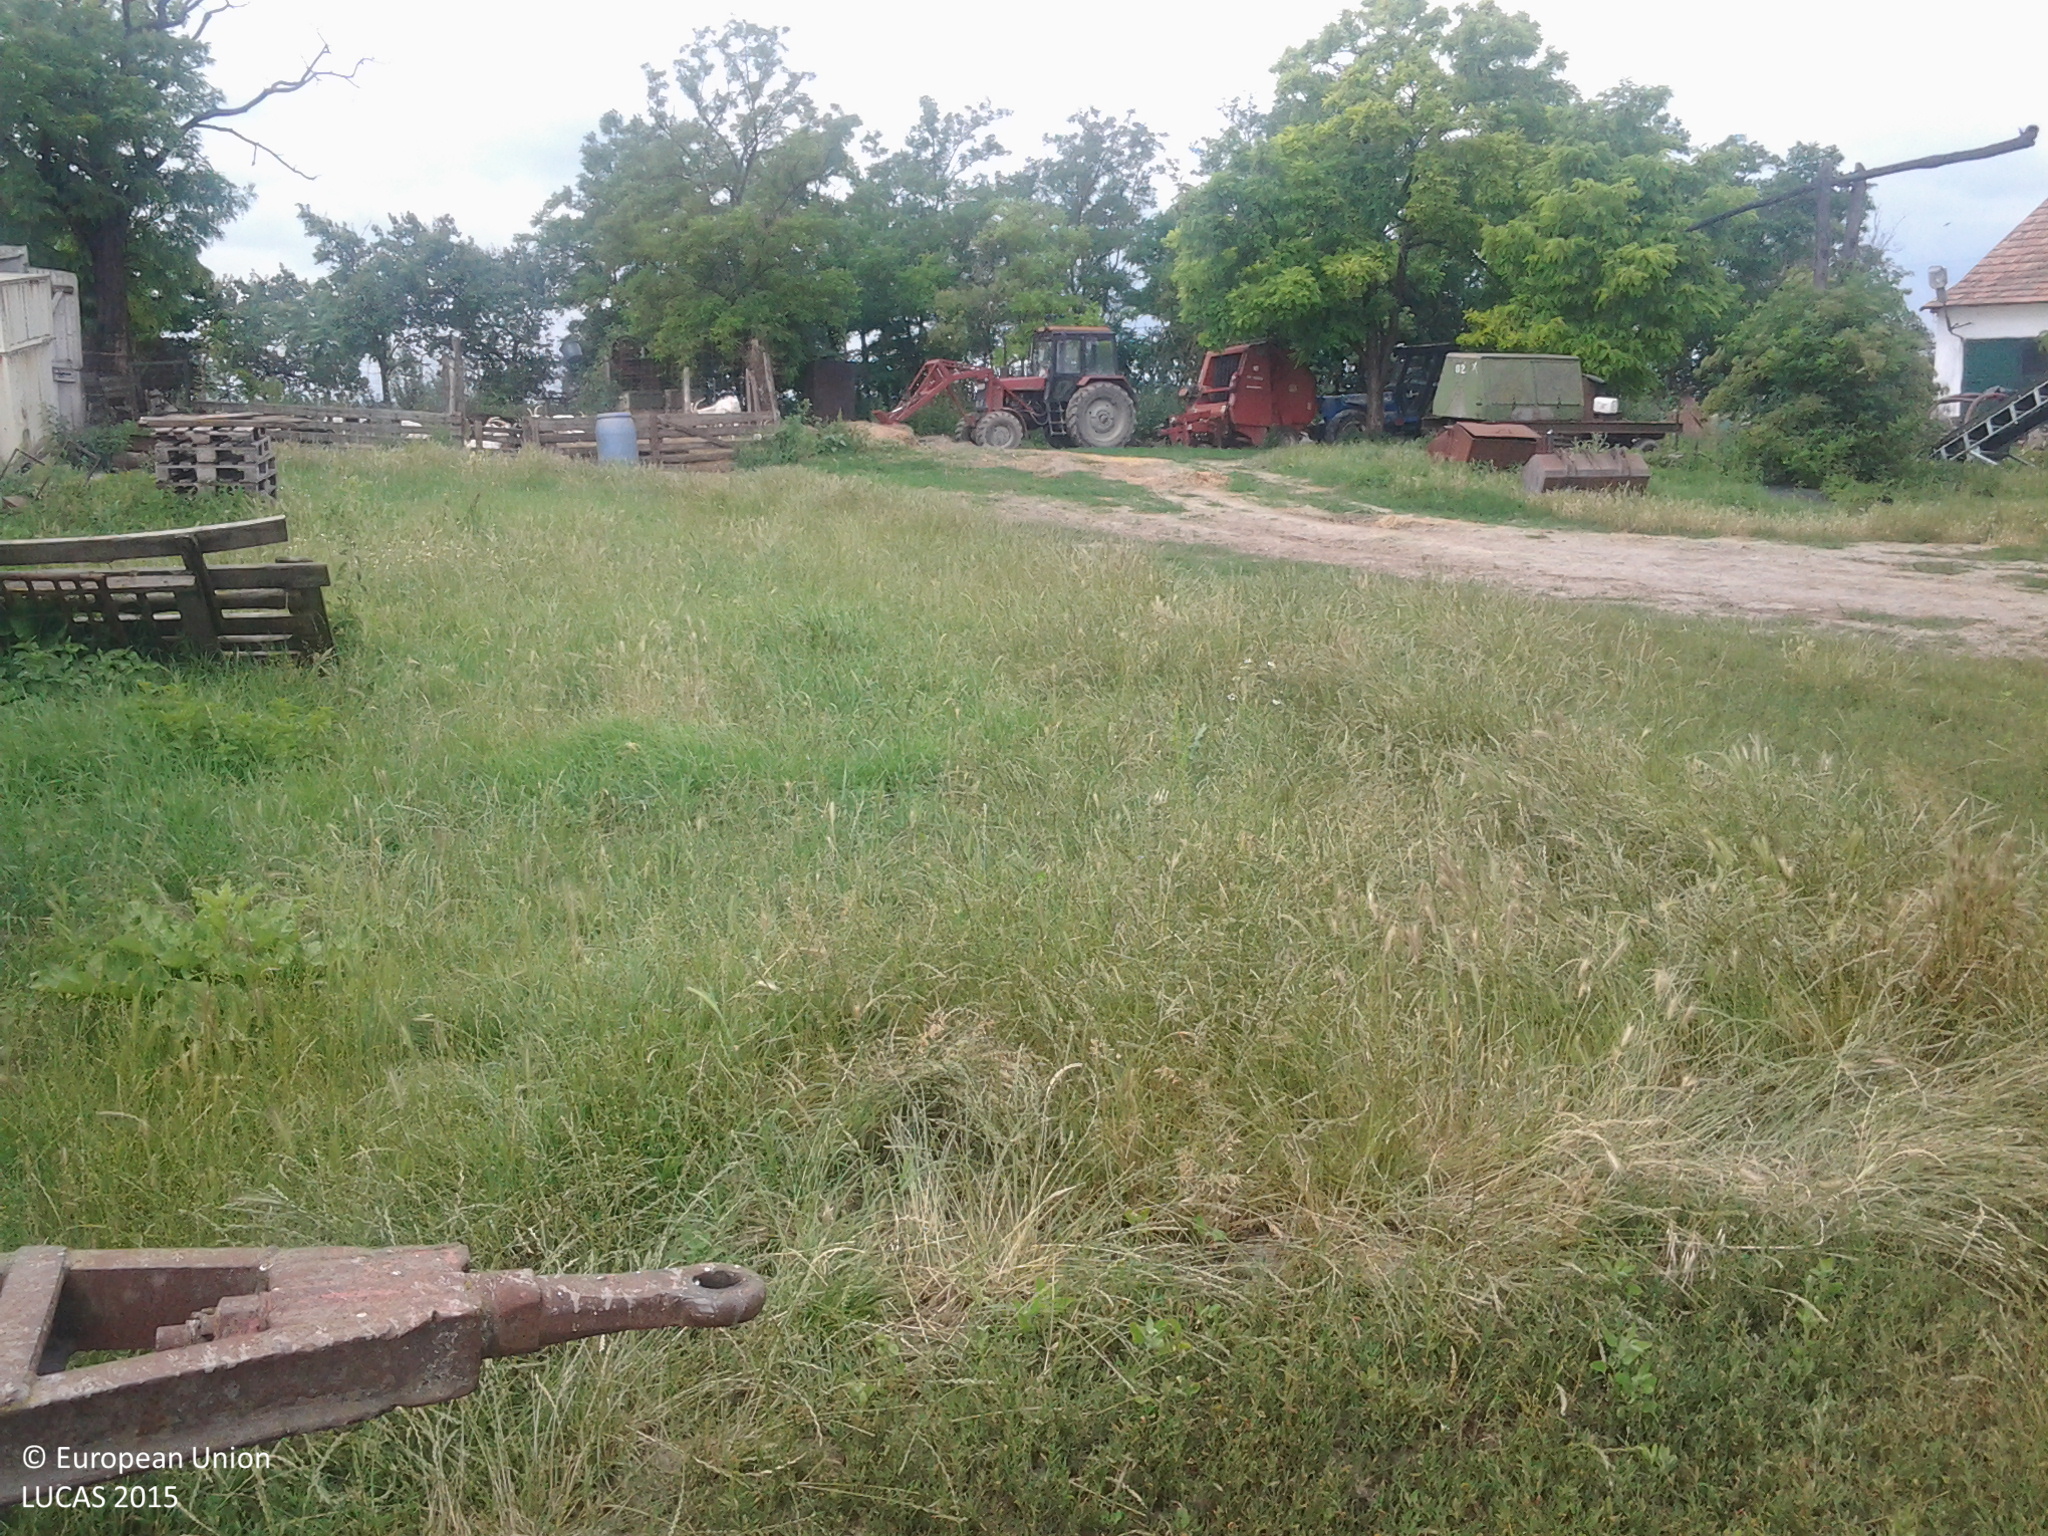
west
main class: Grassland
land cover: Grassland without tree/shrub cover
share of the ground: > 75 %
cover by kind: herbaceous plants 100 %
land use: Agriculture (excluding fallow land and kitchen gardens)
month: June
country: HU
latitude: 46.9929
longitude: 19.1290
